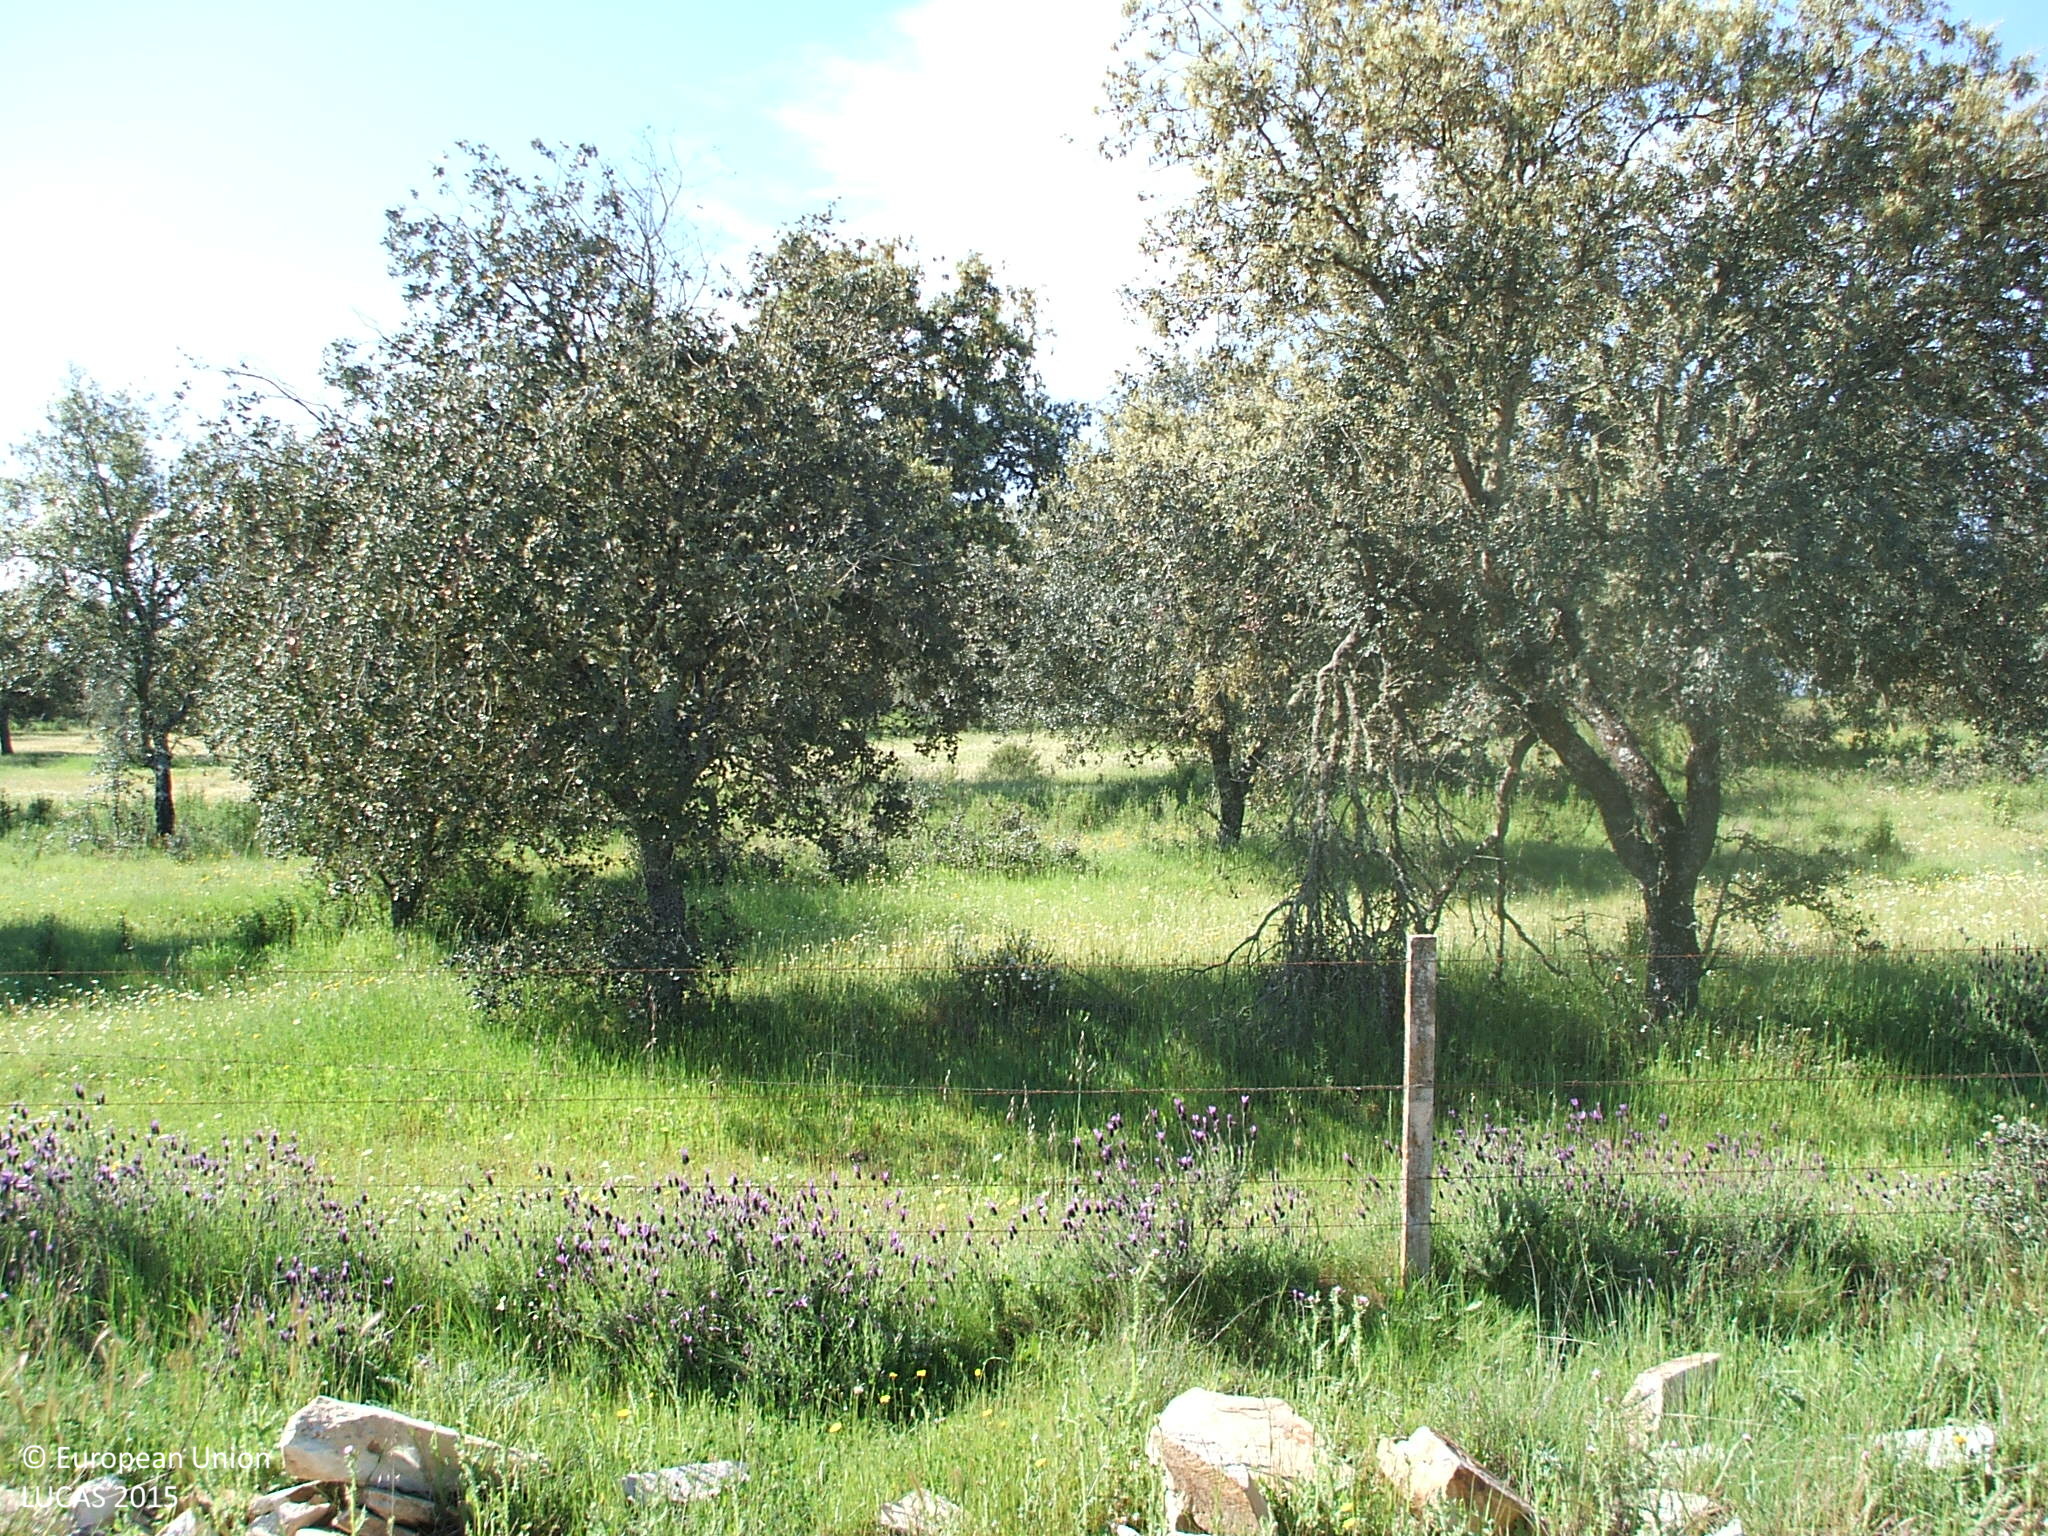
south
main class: Woodland
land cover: Broadleaved woodland
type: broadleaved evergreen forest
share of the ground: 25 - 50 %
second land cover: Grassland without tree/shrub cover
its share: > 75 %
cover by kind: herbaceous plants 75 %, broadleaved forest trees 25 %
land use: Forestry
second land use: Agriculture (excluding fallow land and kitchen gardens)
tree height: > 5 m
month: April
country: ES
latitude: 38.0136
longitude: -5.6221
